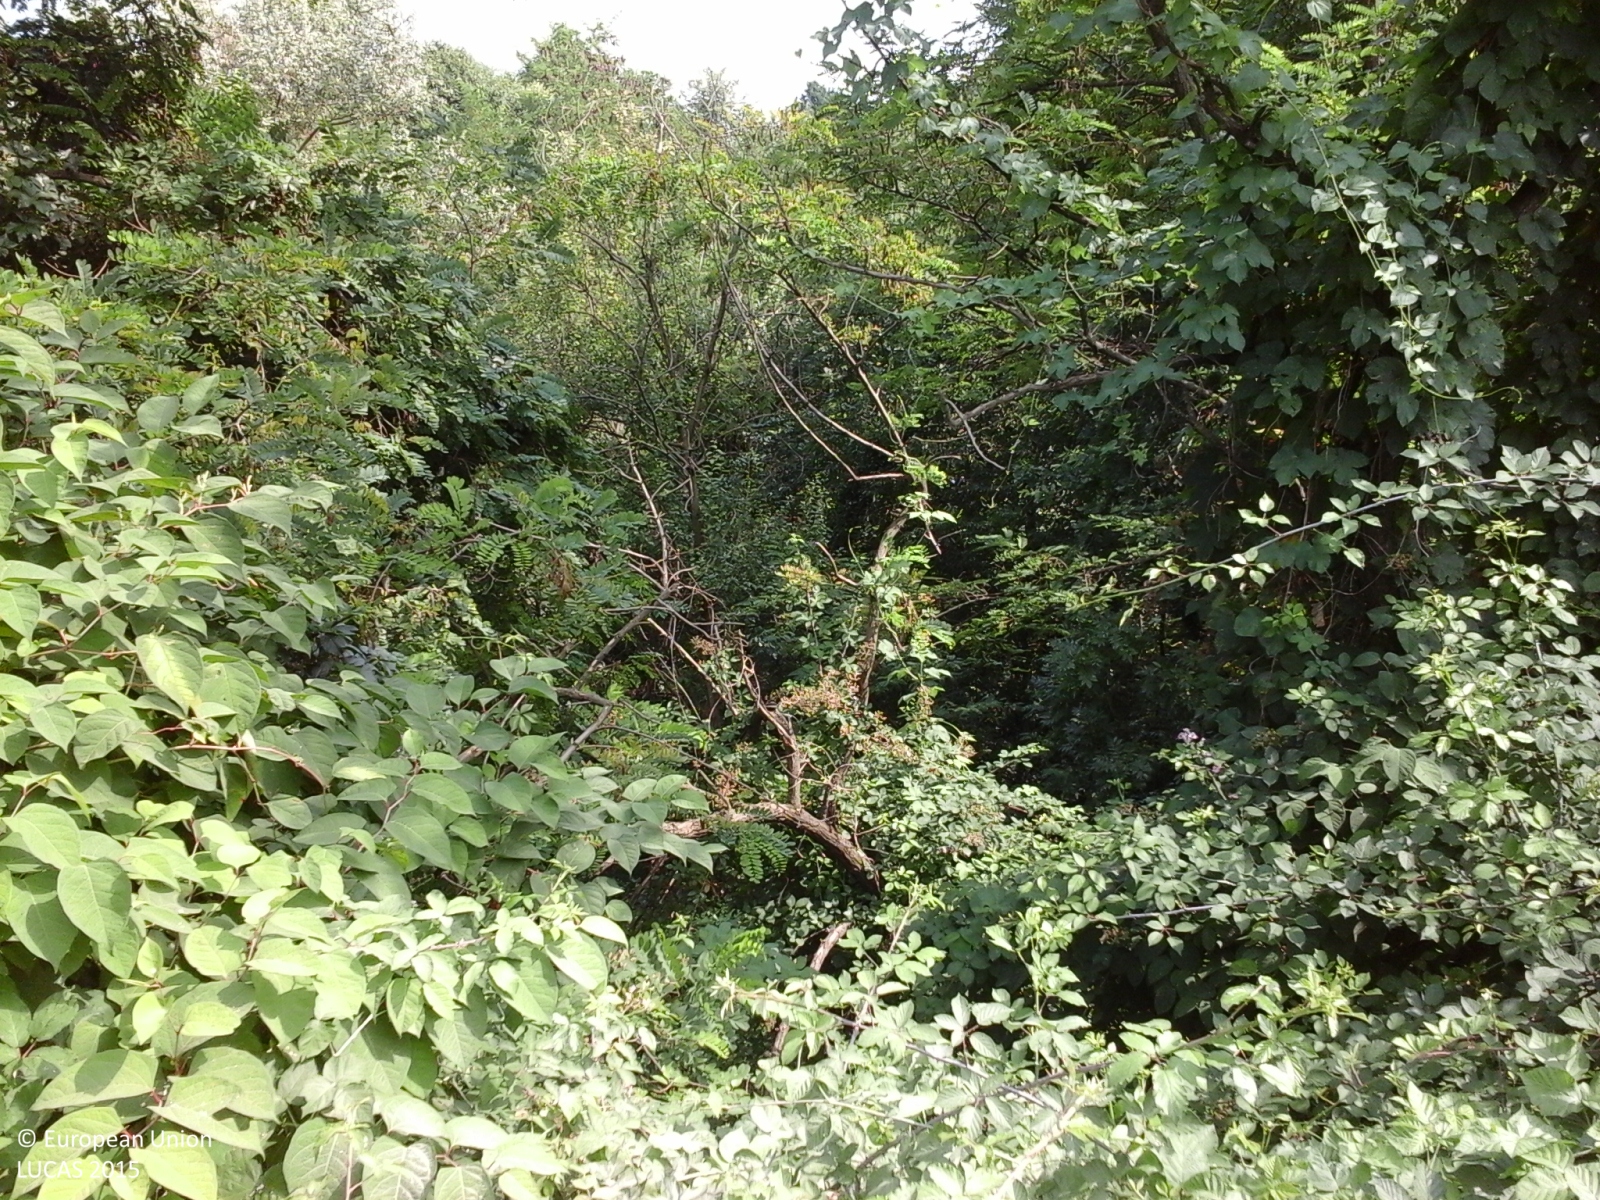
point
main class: Woodland
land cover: Broadleaved woodland
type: thermophilous deciduous forest
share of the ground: > 75 %
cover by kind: broadleaved forest trees 100 %
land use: Semi-natural and natural areas not in use
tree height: > 5 m
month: July
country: IT
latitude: 44.9110
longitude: 7.3069
